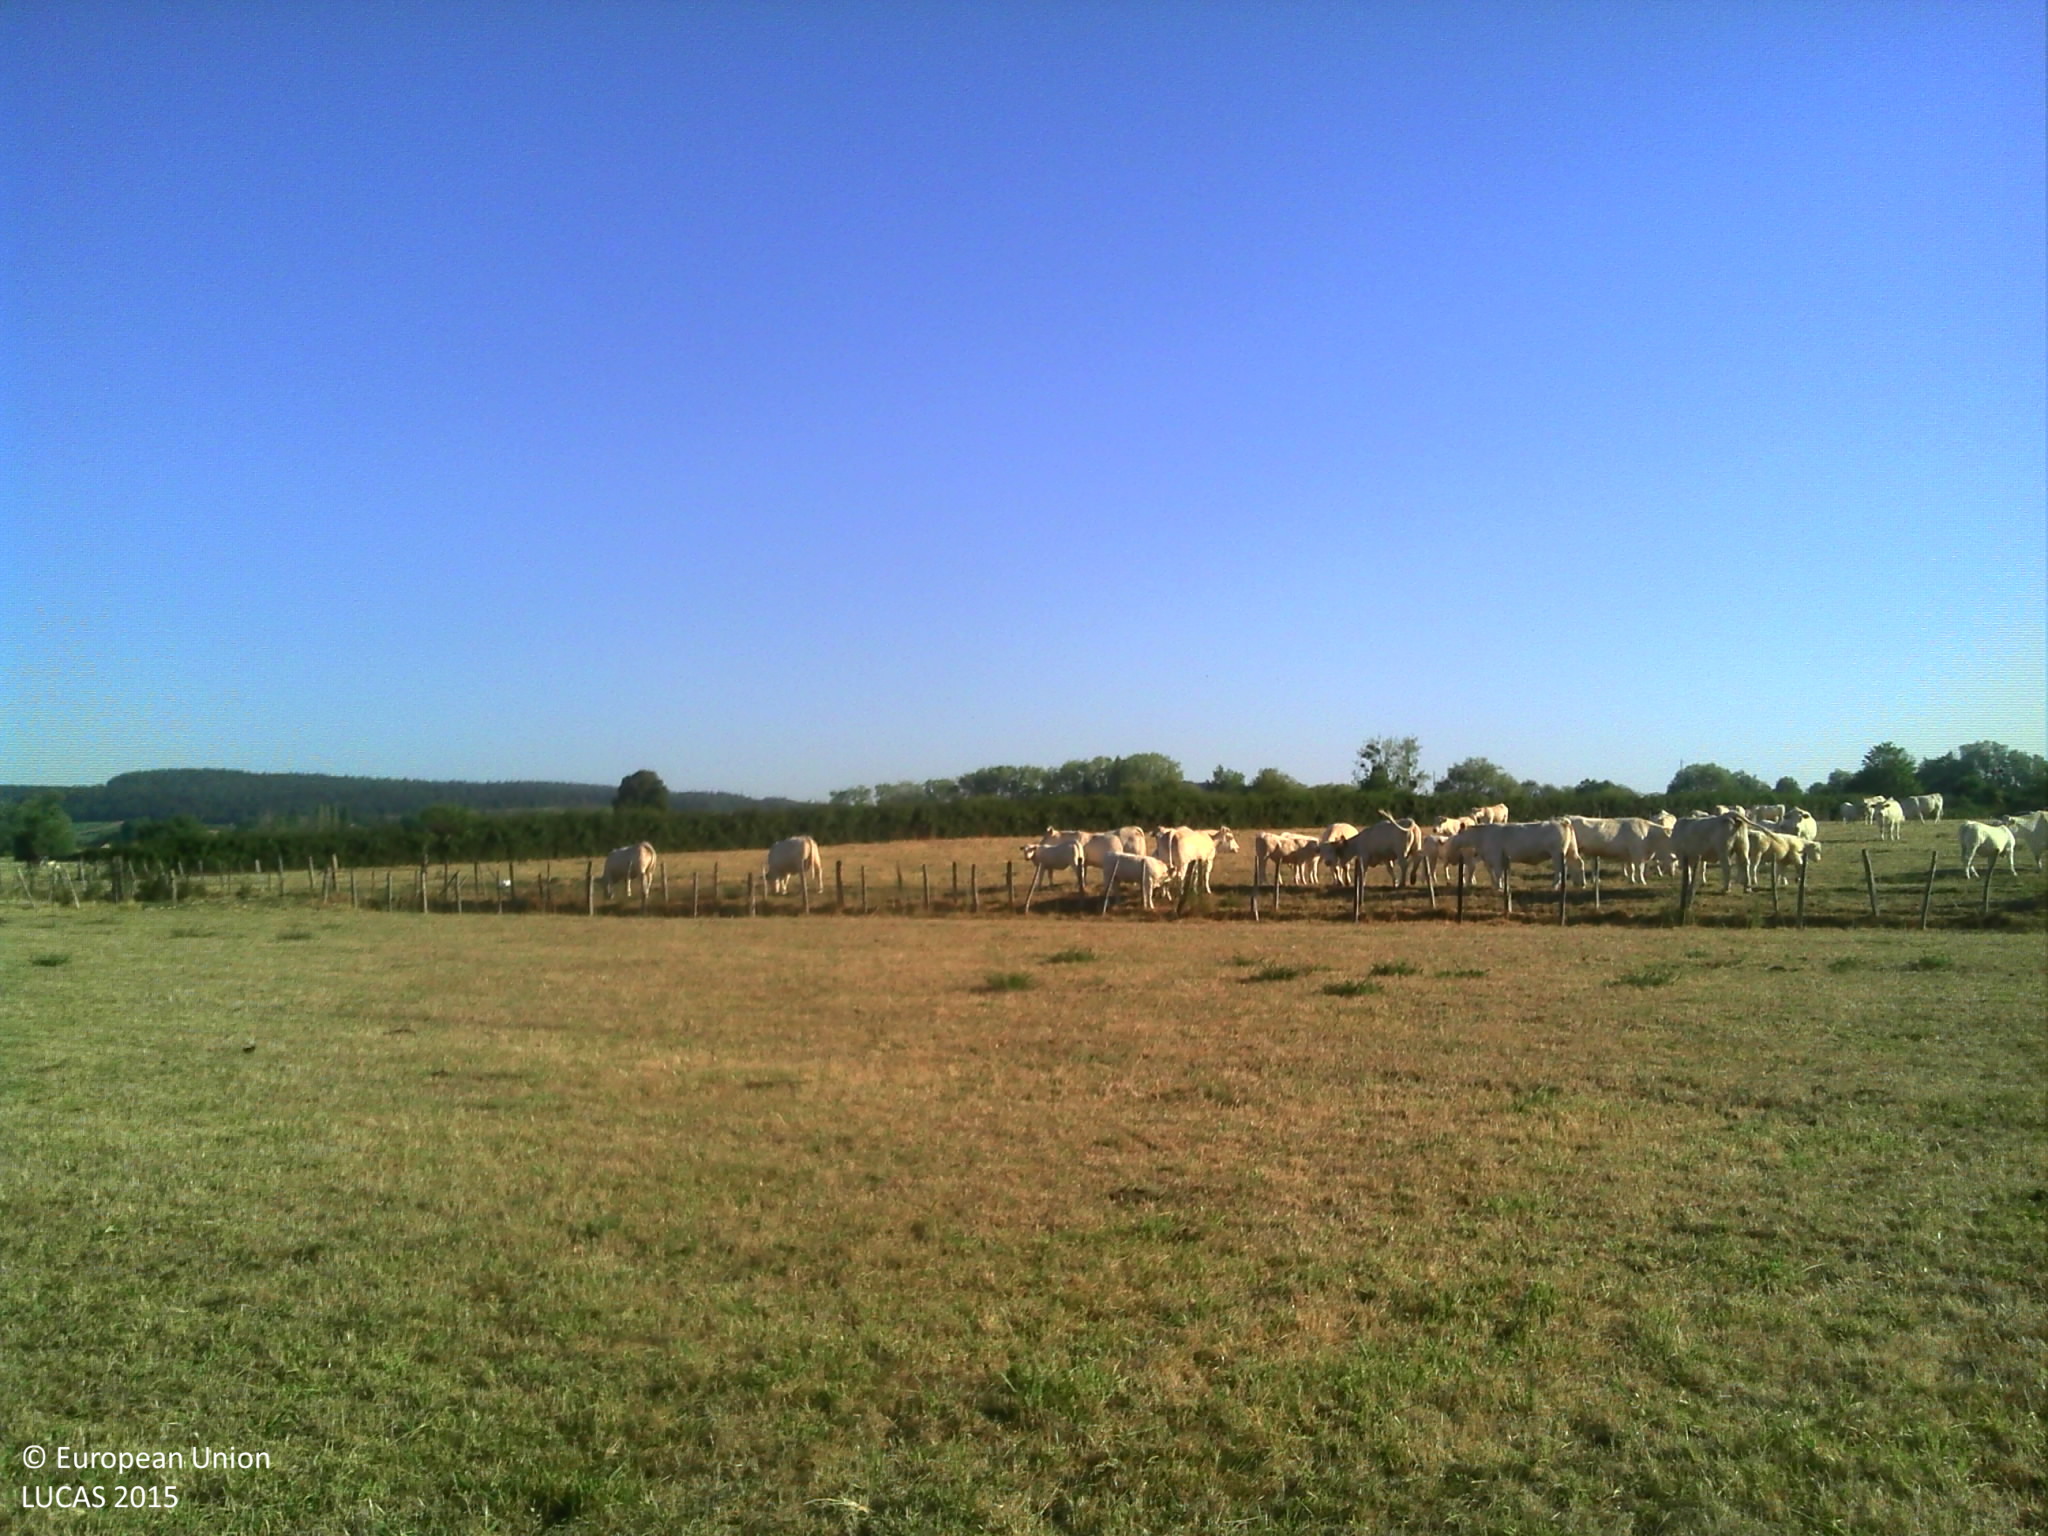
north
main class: Grassland
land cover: Grassland without tree/shrub cover
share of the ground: > 75 %
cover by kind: herbaceous plants 100 %
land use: Agriculture (excluding fallow land and kitchen gardens)
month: August
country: FR
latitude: 46.8176
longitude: 4.7453
